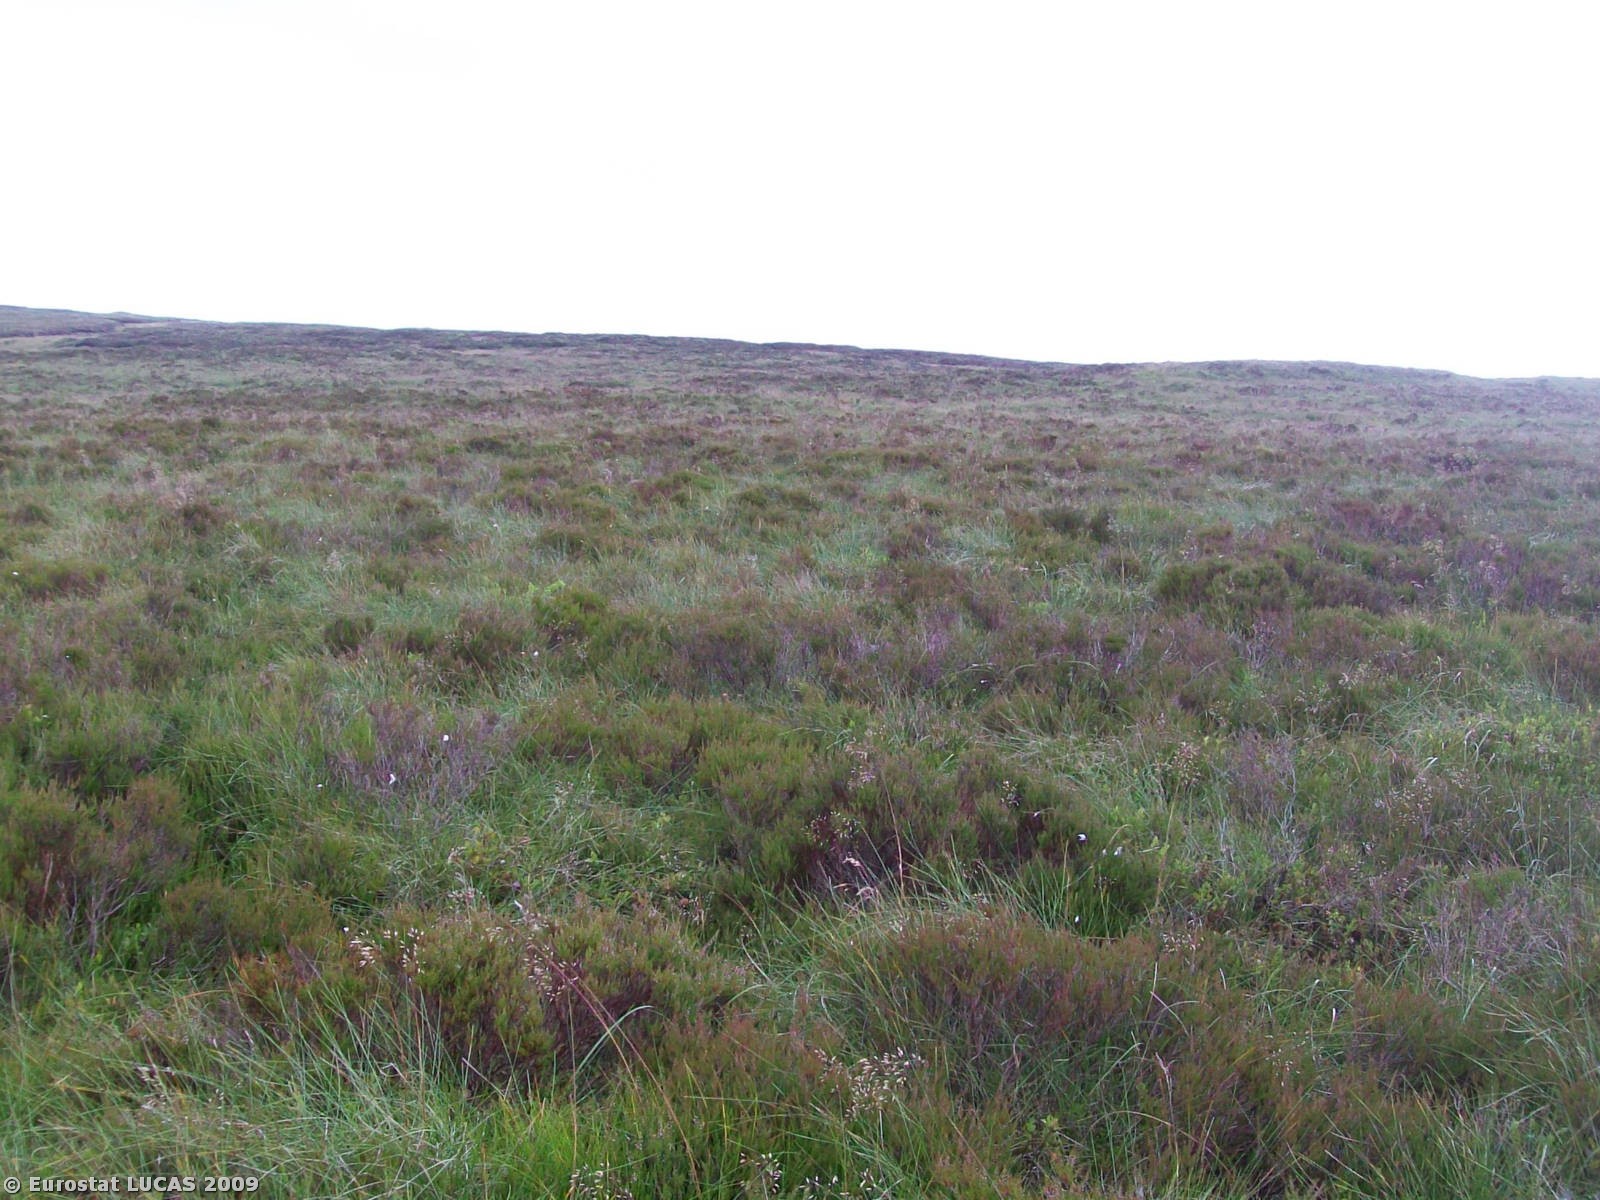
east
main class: Wetlands
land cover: Peatbogs
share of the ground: > 75 %
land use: Unused
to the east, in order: Peatbogs
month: July
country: GB
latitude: 55.0142
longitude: -6.2382
